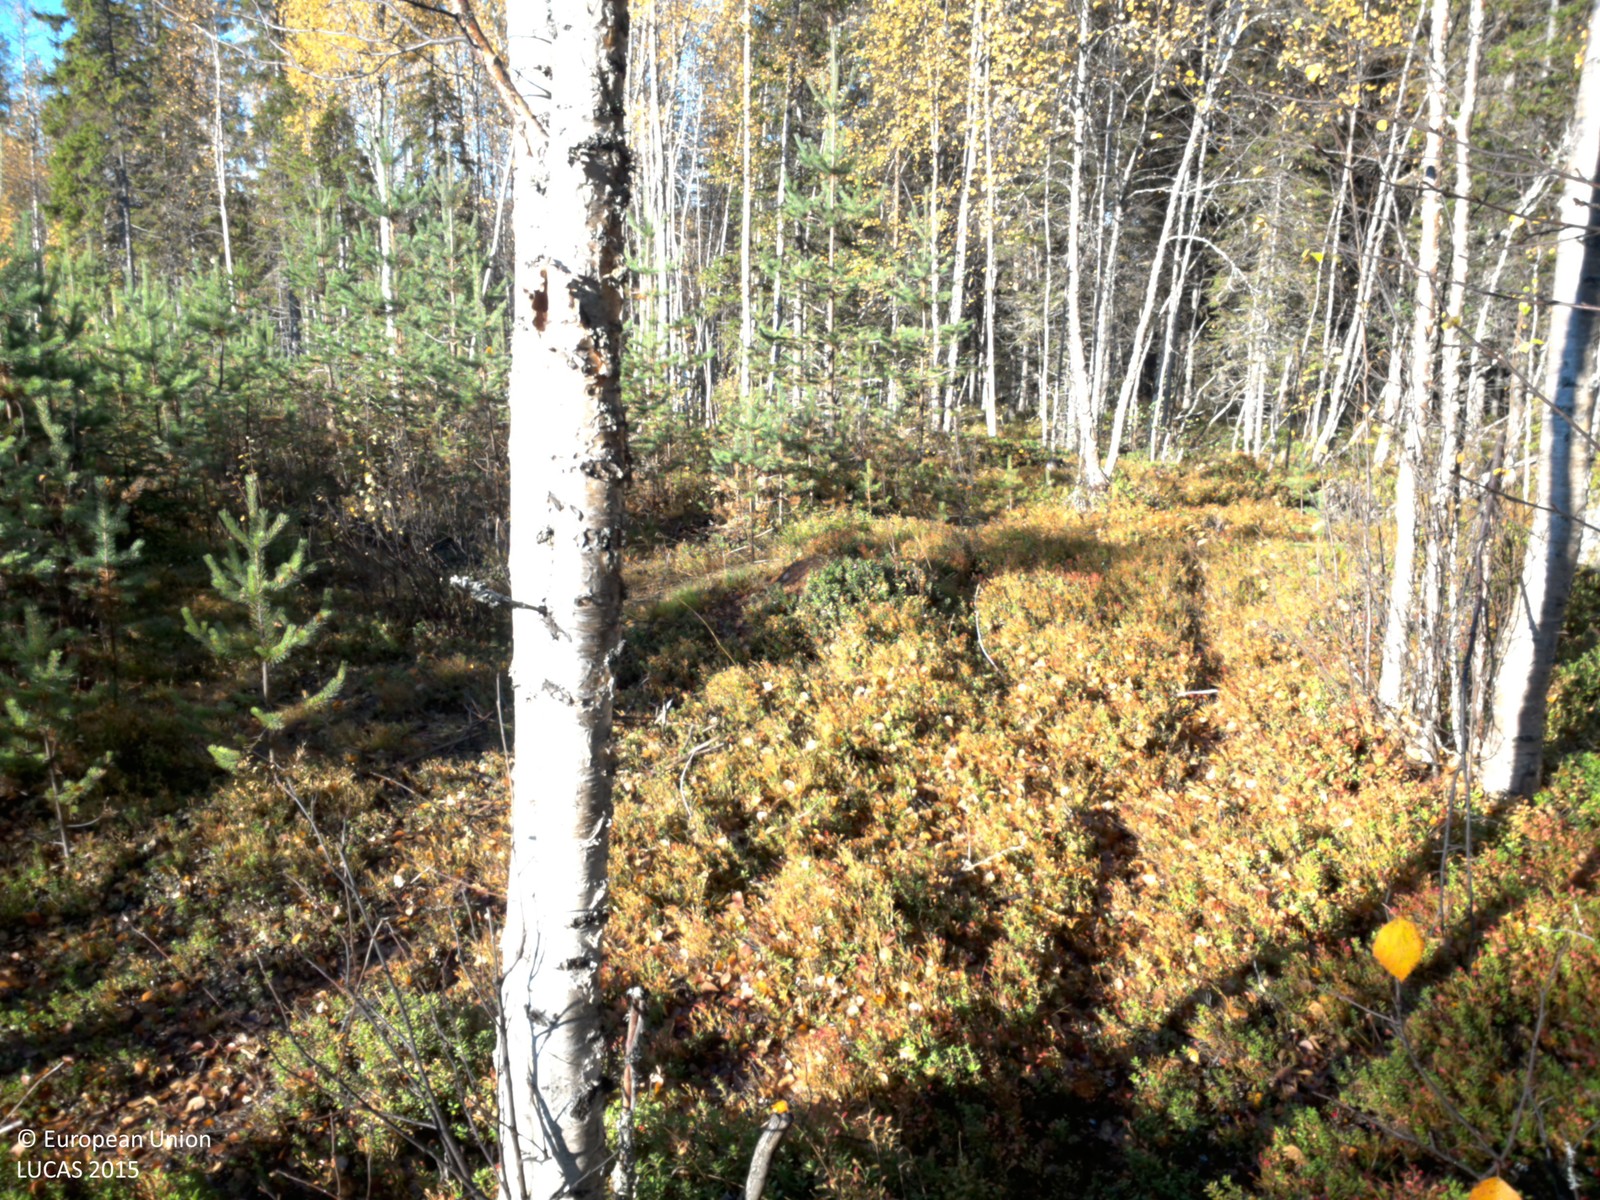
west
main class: Woodland
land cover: Pine dominated mixed woodland
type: boreal forest
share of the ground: > 75 %
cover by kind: coniferous forest trees 60 %, broadleaved forest trees 20 %, shrubs 15 %, lichens and mosses 5 %
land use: Forestry
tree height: > 5 m
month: September
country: SE
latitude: 64.8156
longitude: 19.0024
